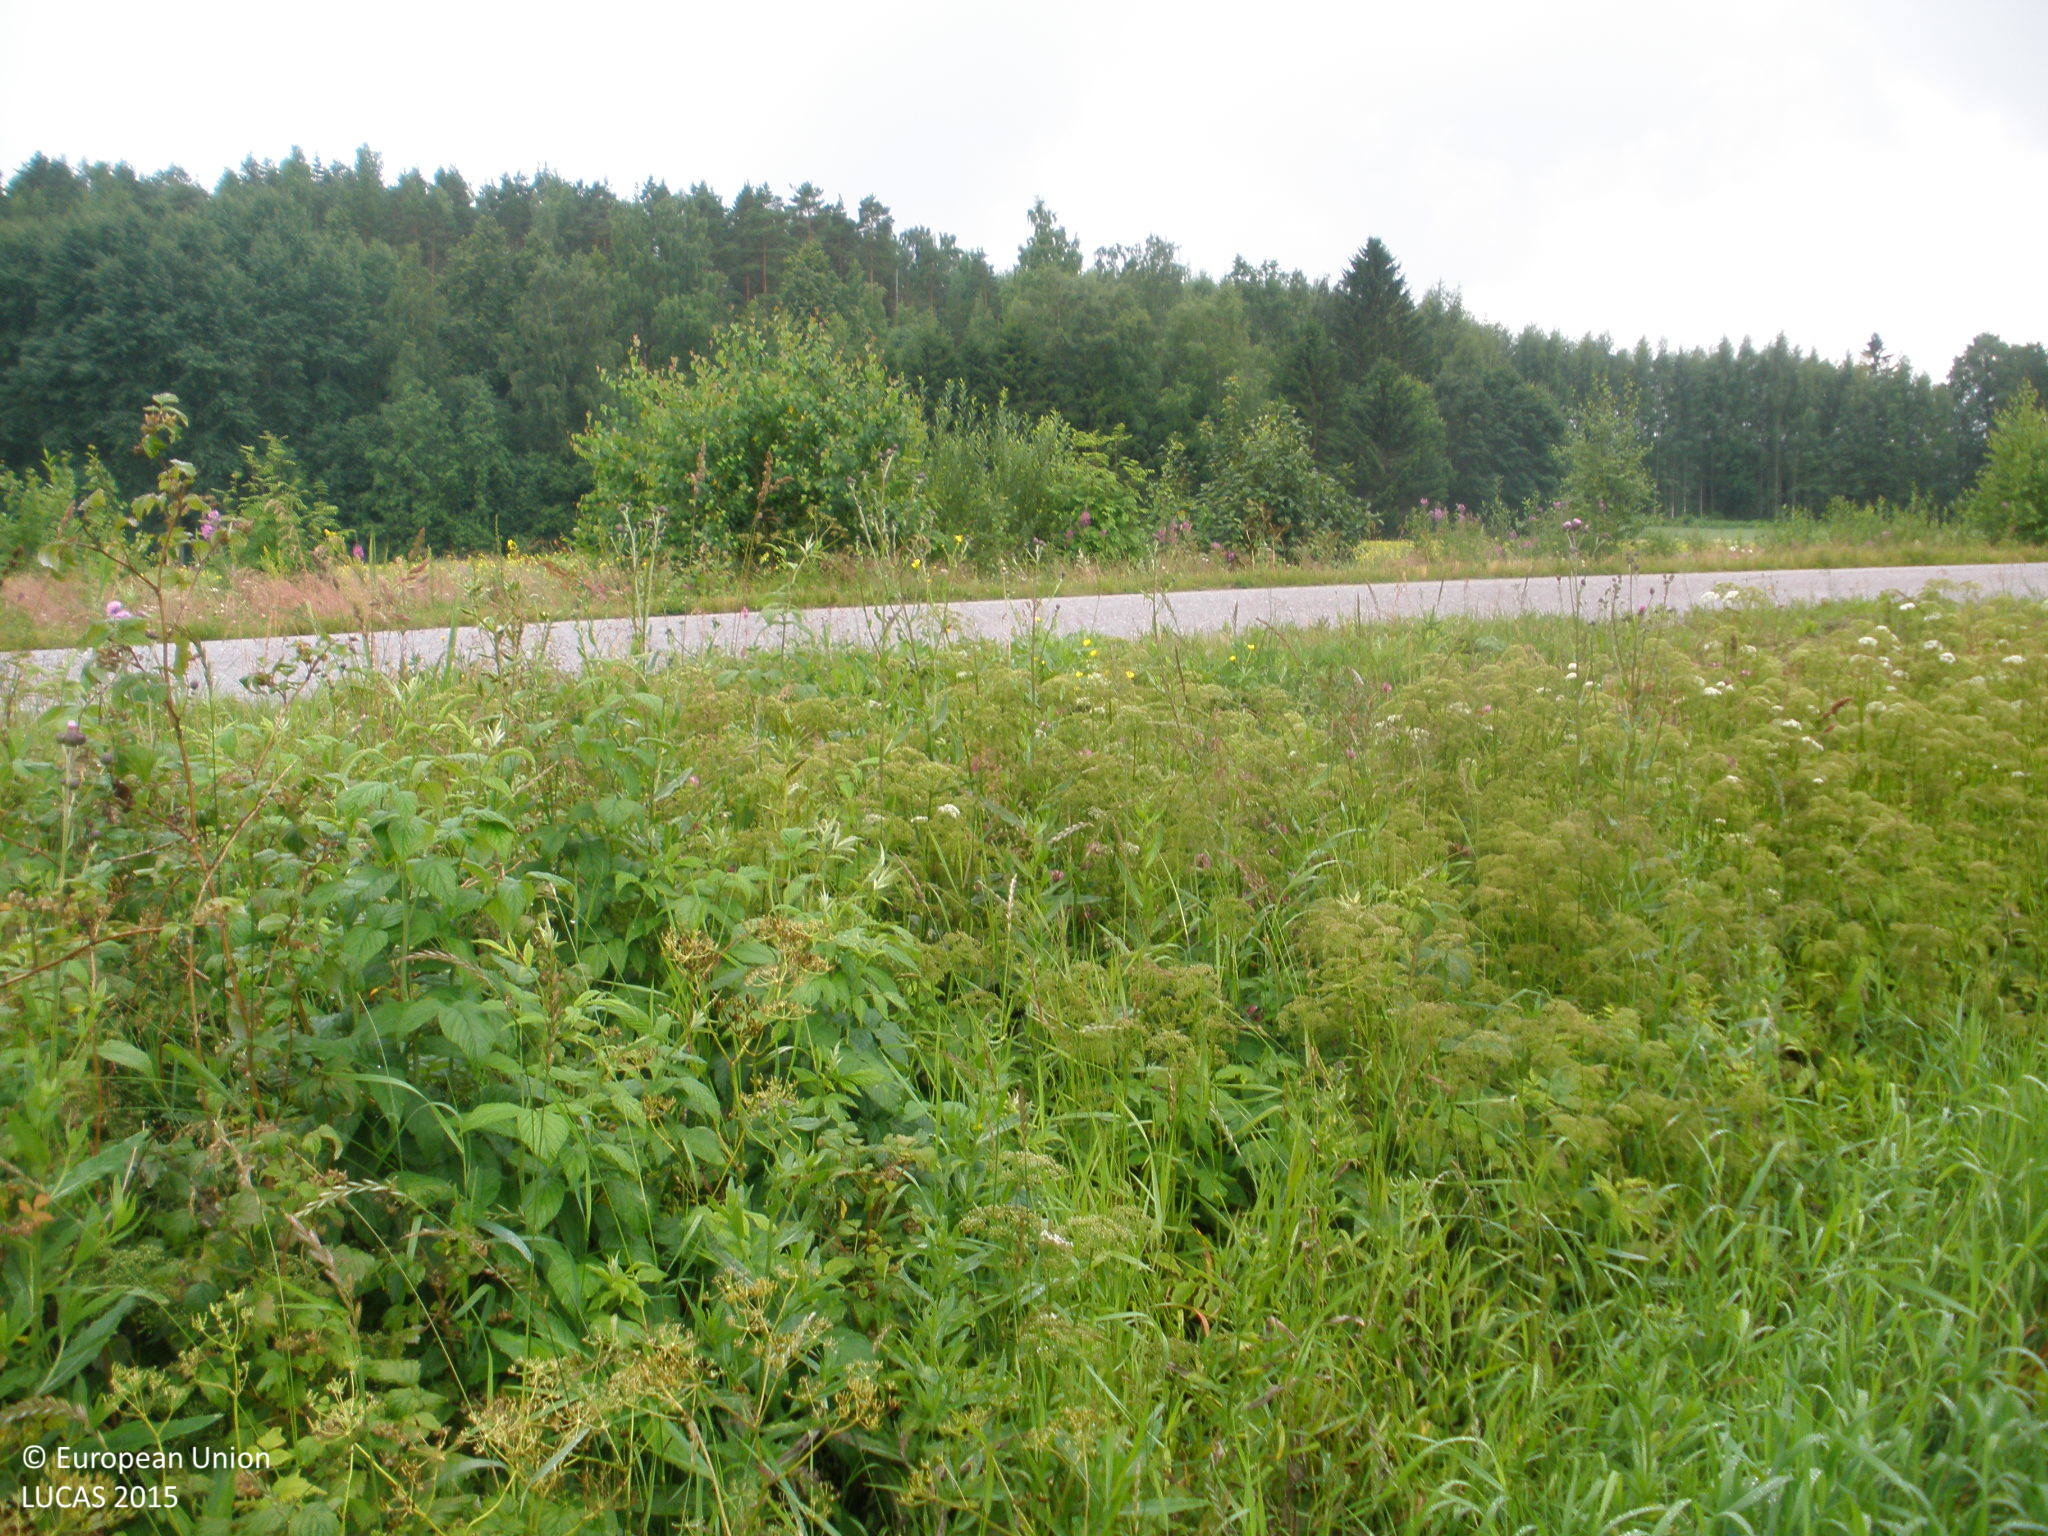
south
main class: Cropland
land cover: Barley
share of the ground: 25 - 50 %
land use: Agriculture (excluding fallow land and kitchen gardens)
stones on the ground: < 10 %
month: July
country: FI
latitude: 61.1606
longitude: 24.7705
